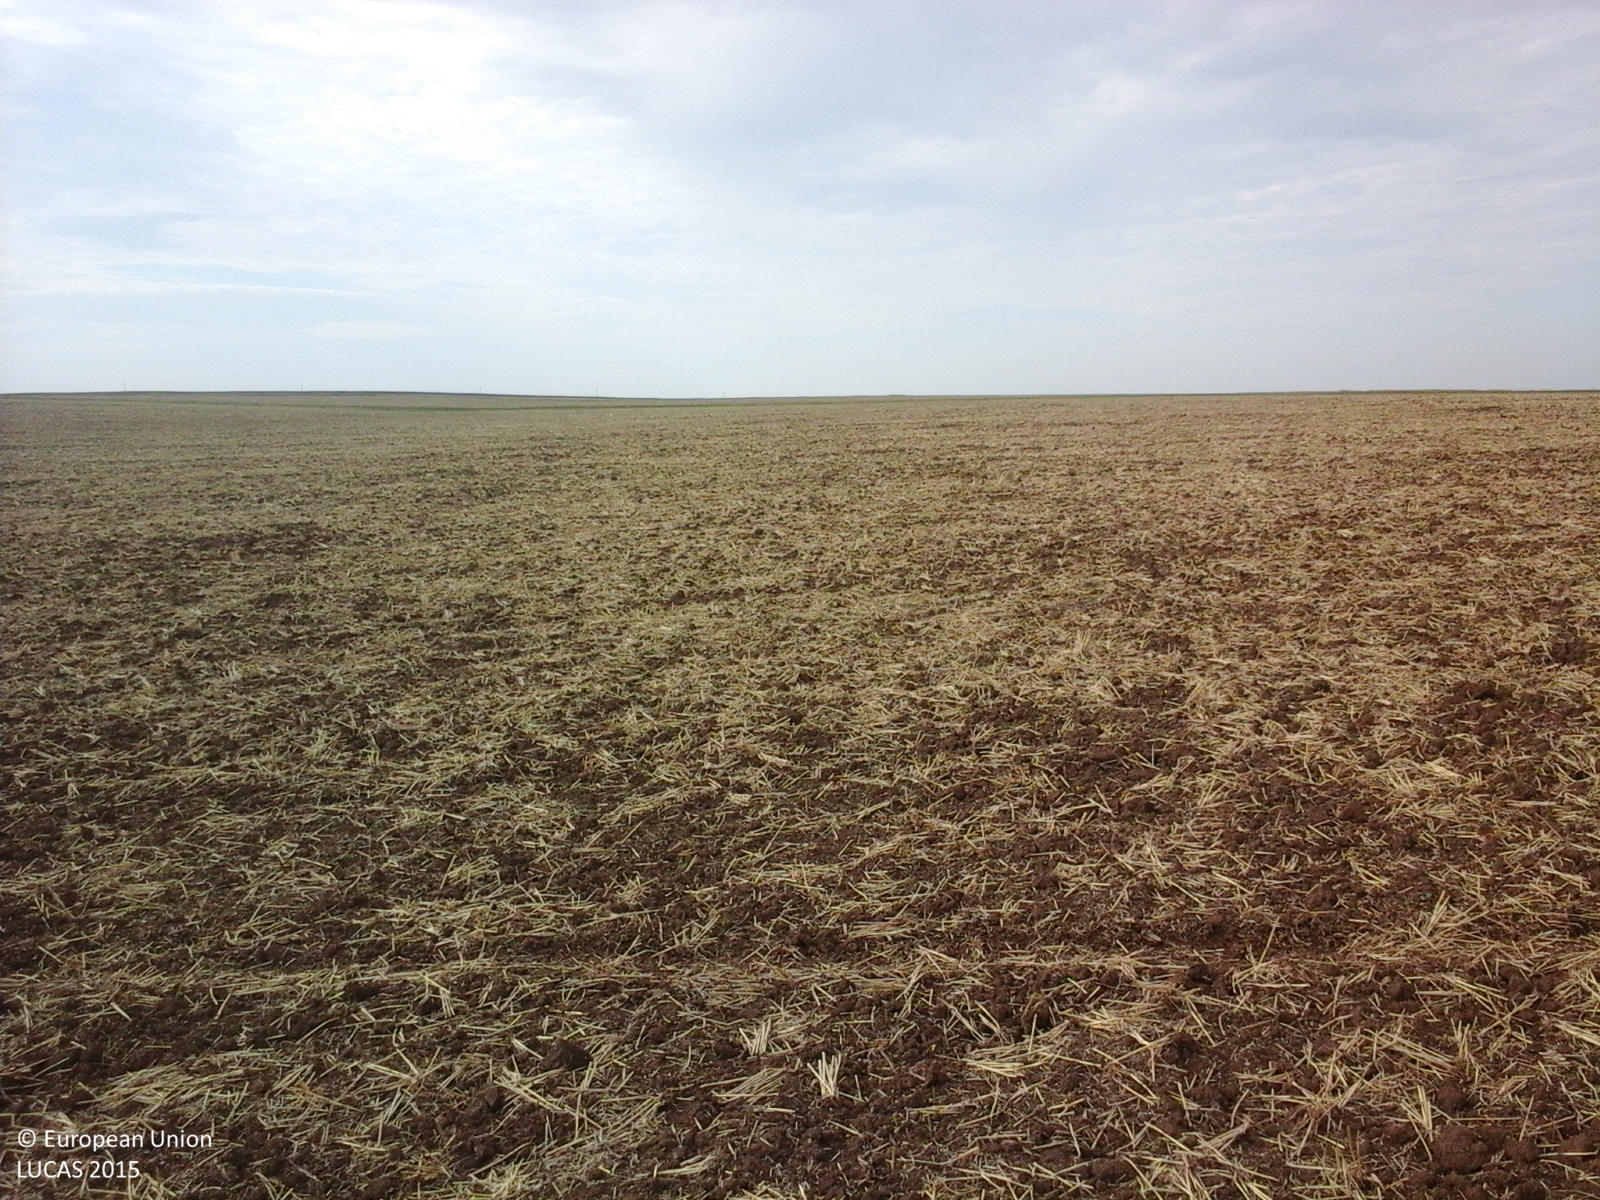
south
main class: Cropland
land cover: Common wheat
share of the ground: 25 - 50 %
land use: Agriculture (excluding fallow land and kitchen gardens)
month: August
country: RO
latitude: 46.0904
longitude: 21.3506
